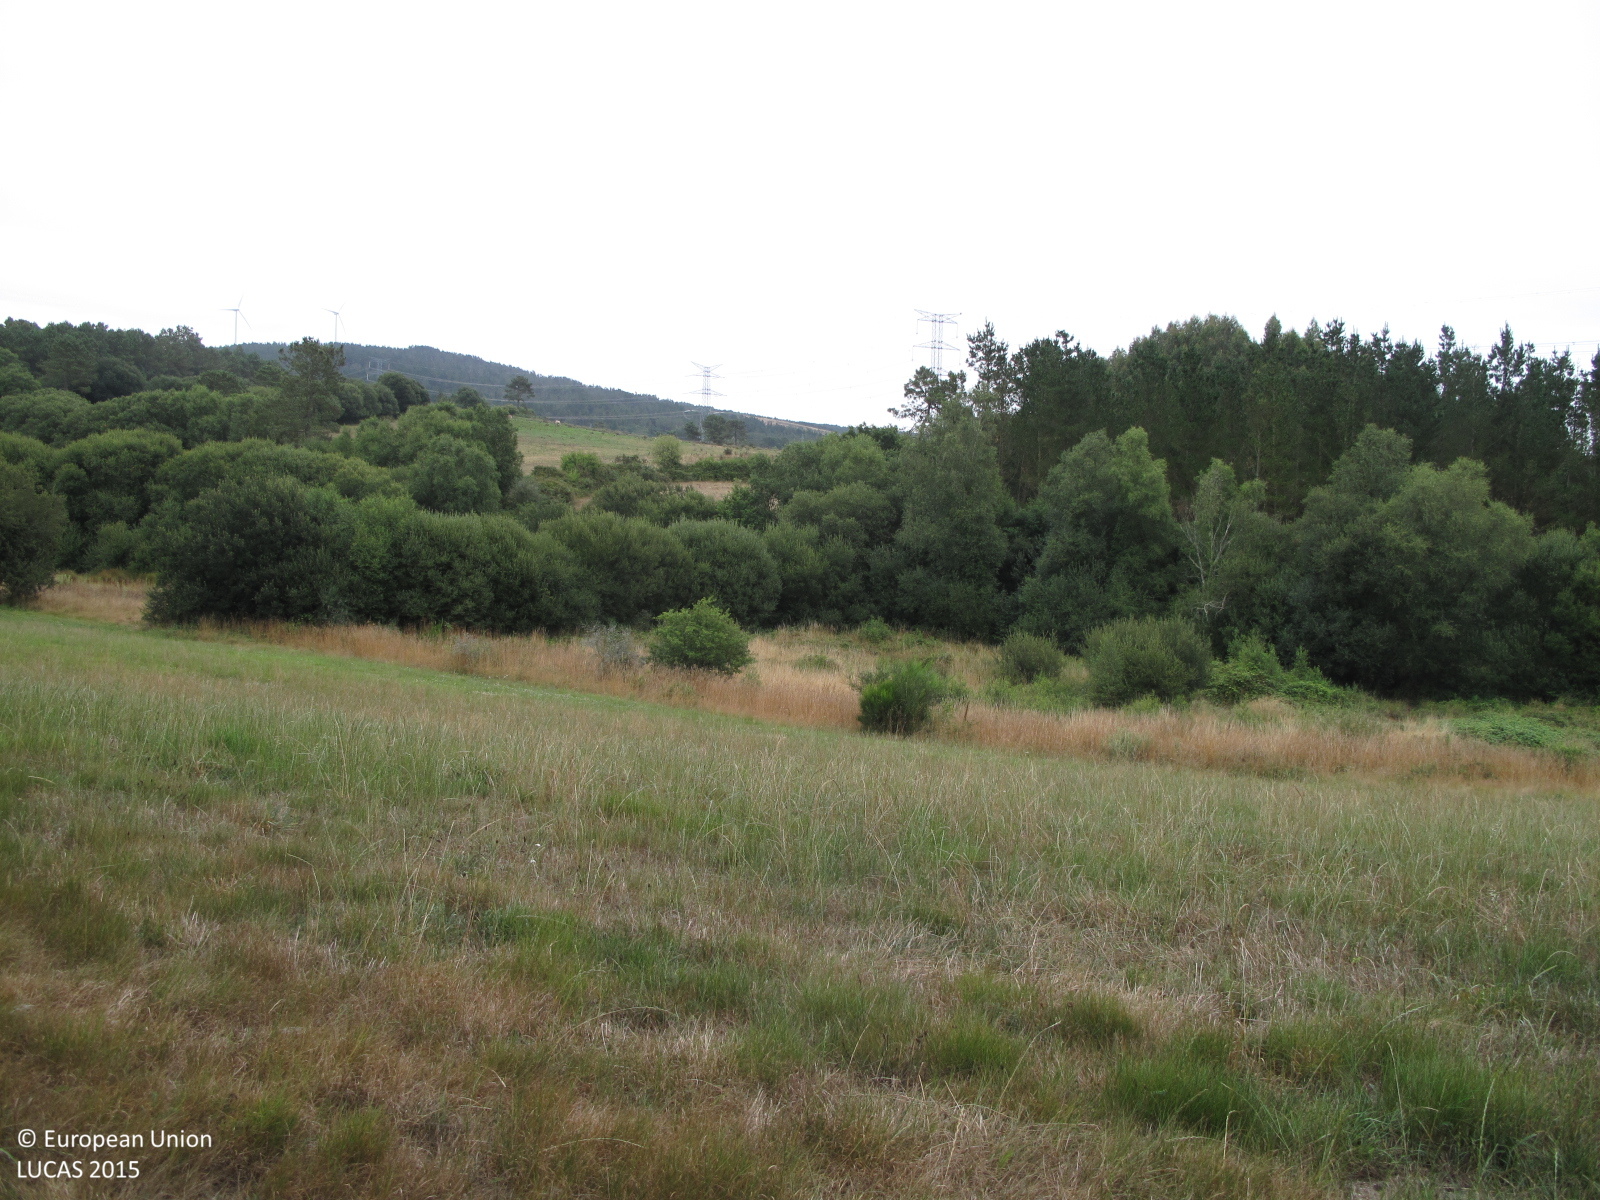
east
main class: Woodland
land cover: Pine dominated coniferous woodland
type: hemiboreal forest and nemoral coniferous forest and mixed broadleaved-coniferous forest
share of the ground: 50 - 75 %
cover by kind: coniferous forest trees 60 %, shrubs 40 %
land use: Forestry
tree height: > 5 m
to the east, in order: Pine dominated coniferous woodland; Grassland without tree/shrub cover; Broadleaved woodland; Rivers and streams; Broadleaved woodland; Grassland without tree/shrub cover; Shrubland with sparse tree cover; Grassland with sparse tree/shrub cover
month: July
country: ES
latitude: 43.2076
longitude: -7.9756
